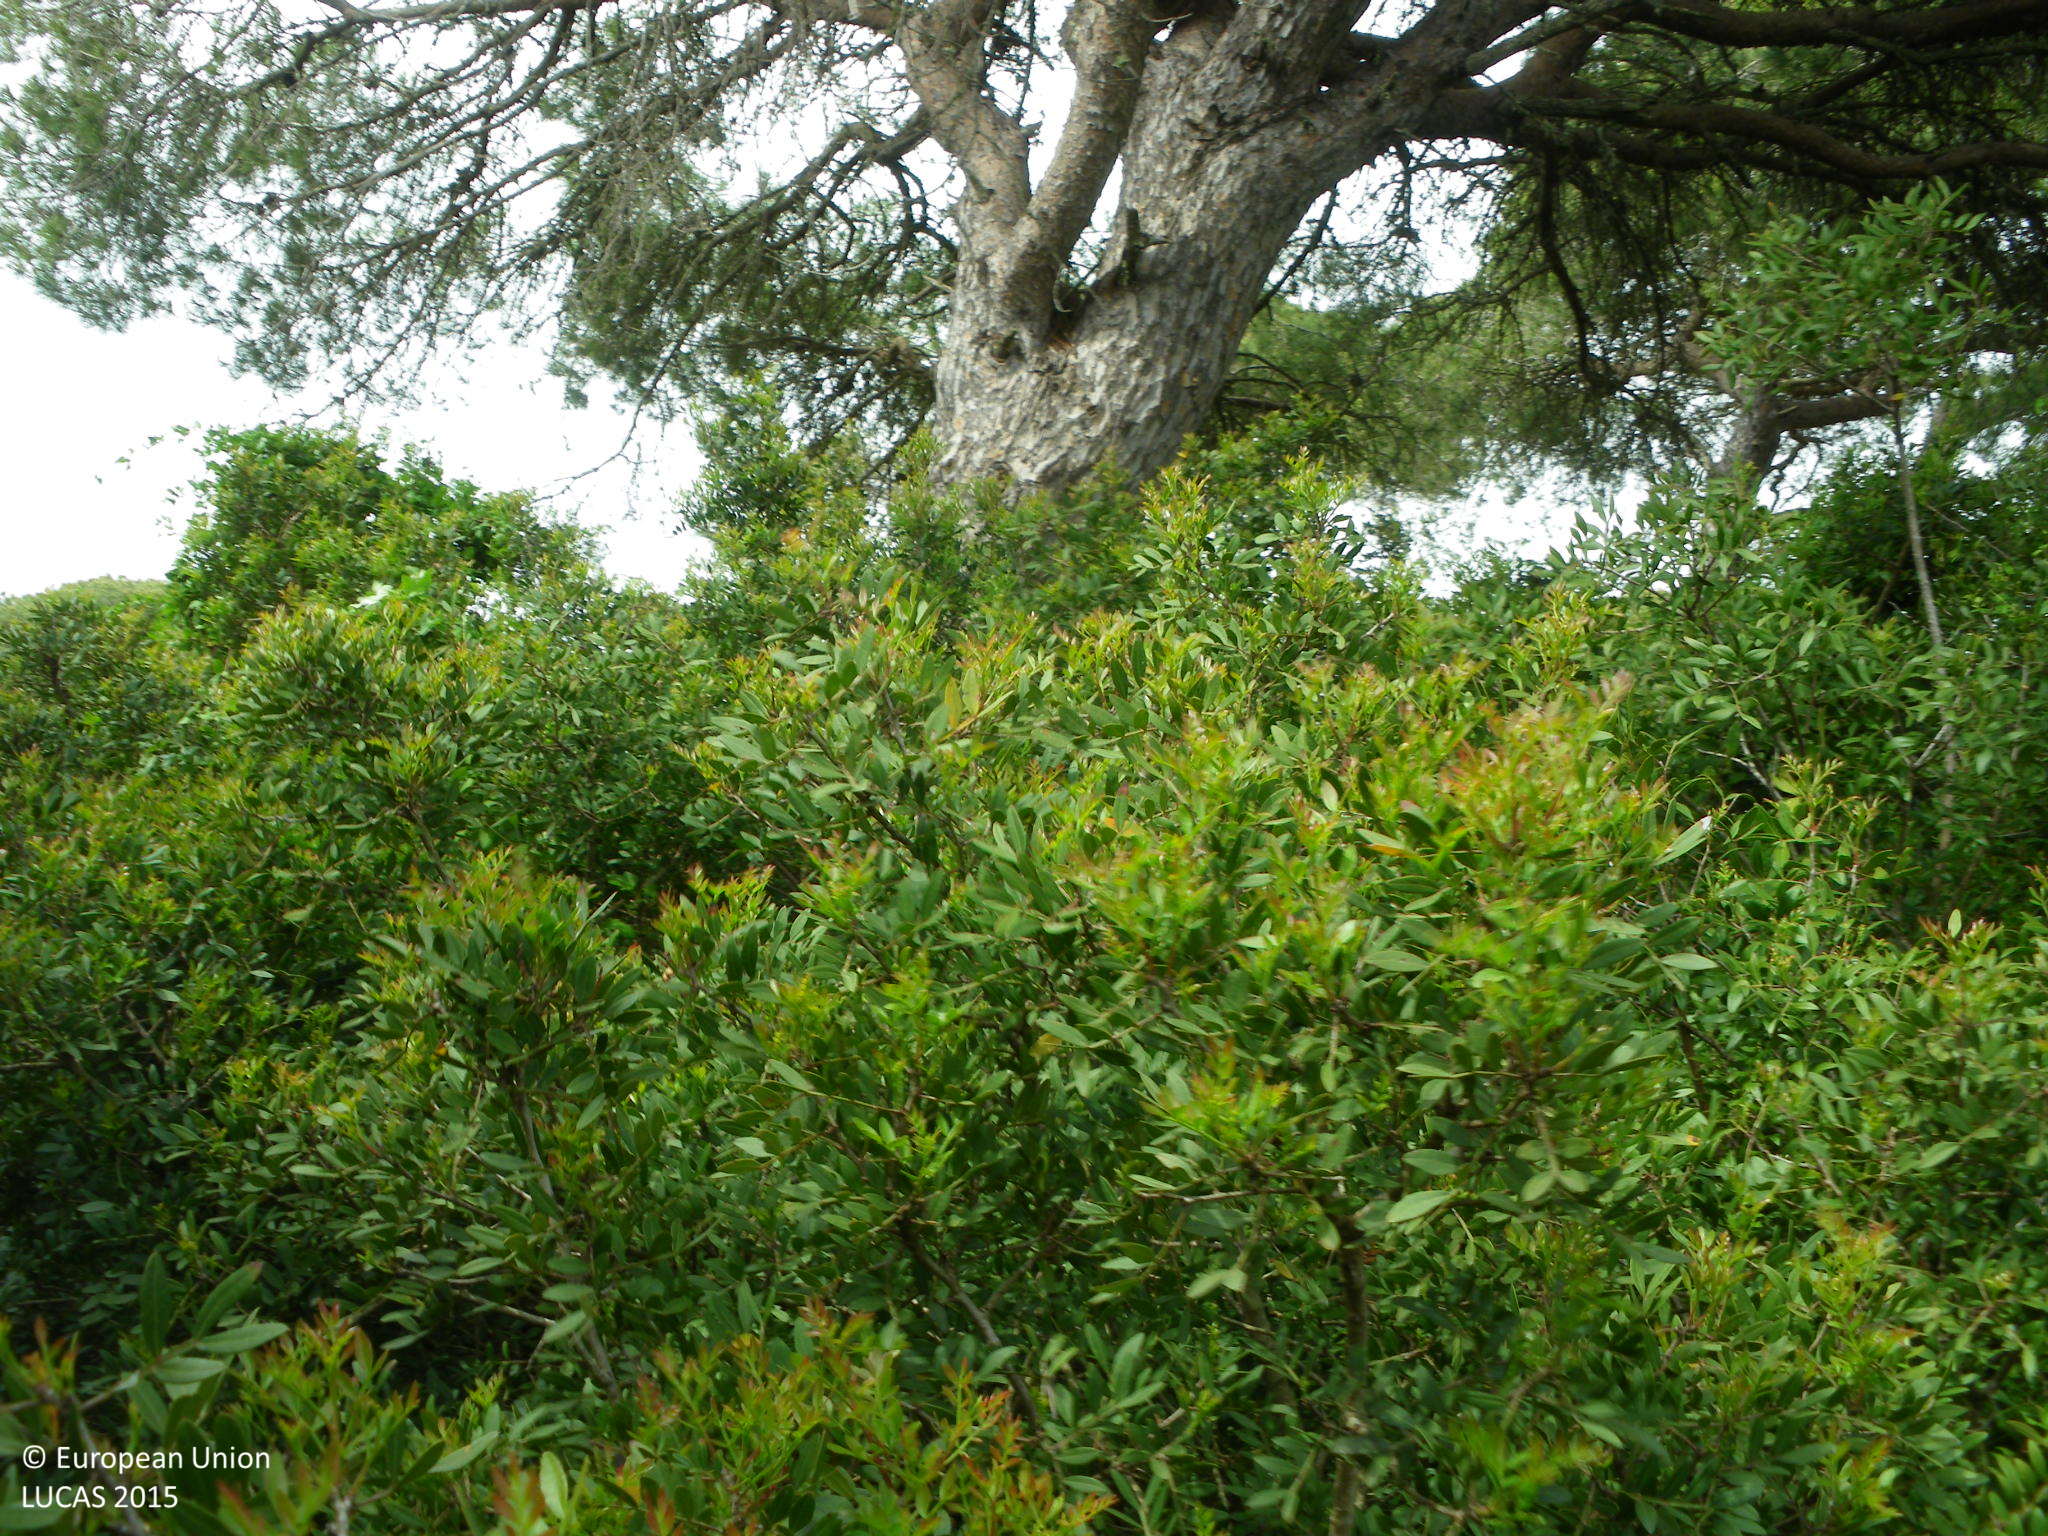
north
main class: Woodland
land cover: Pine dominated coniferous woodland
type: coniferous forest of the mediterranean region
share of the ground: 50 - 75 %
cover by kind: coniferous forest trees 55 %, shrubs 35 %, herbaceous plants 5 %, unconsolidated bare surface 5 %
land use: Forestry
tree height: > 5 m
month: April
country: ES
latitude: 36.3845
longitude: -6.2050
